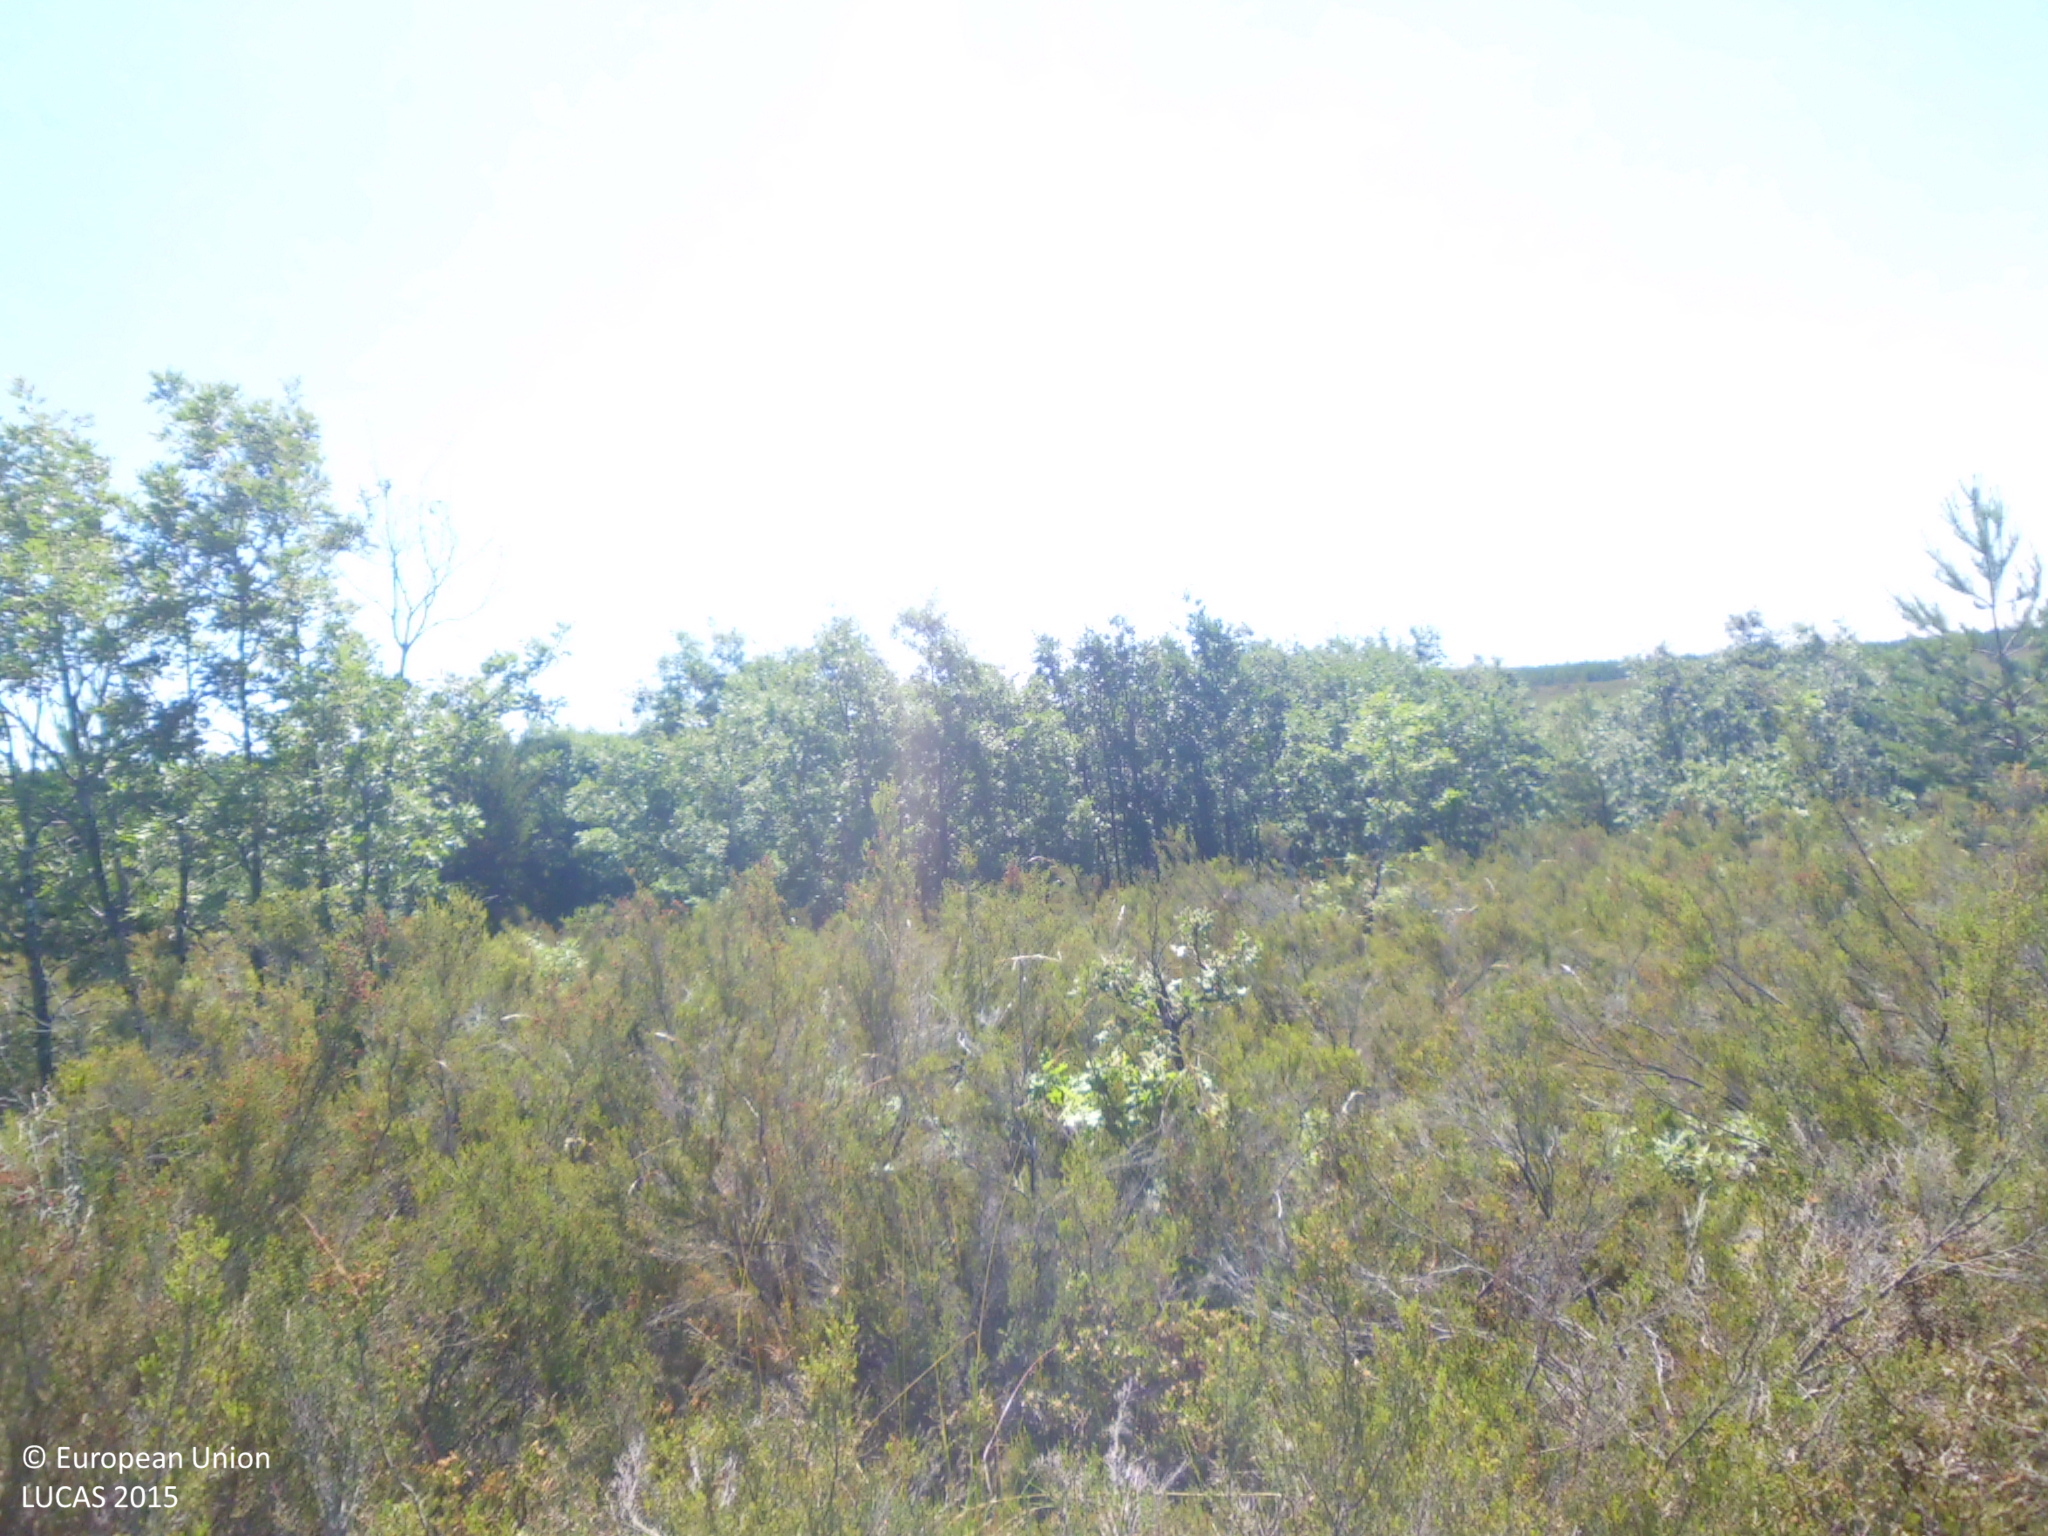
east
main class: Shrubland
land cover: Shrubland without tree cover
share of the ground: > 75 %
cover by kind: shrubs 95 %, herbaceous plants 5 %
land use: Abandoned areas
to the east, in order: Shrubland without tree cover; Shrubland with sparse tree cover; Other structural elements; Shrubland without tree cover
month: June
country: ES
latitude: 42.7714
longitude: -4.9107
